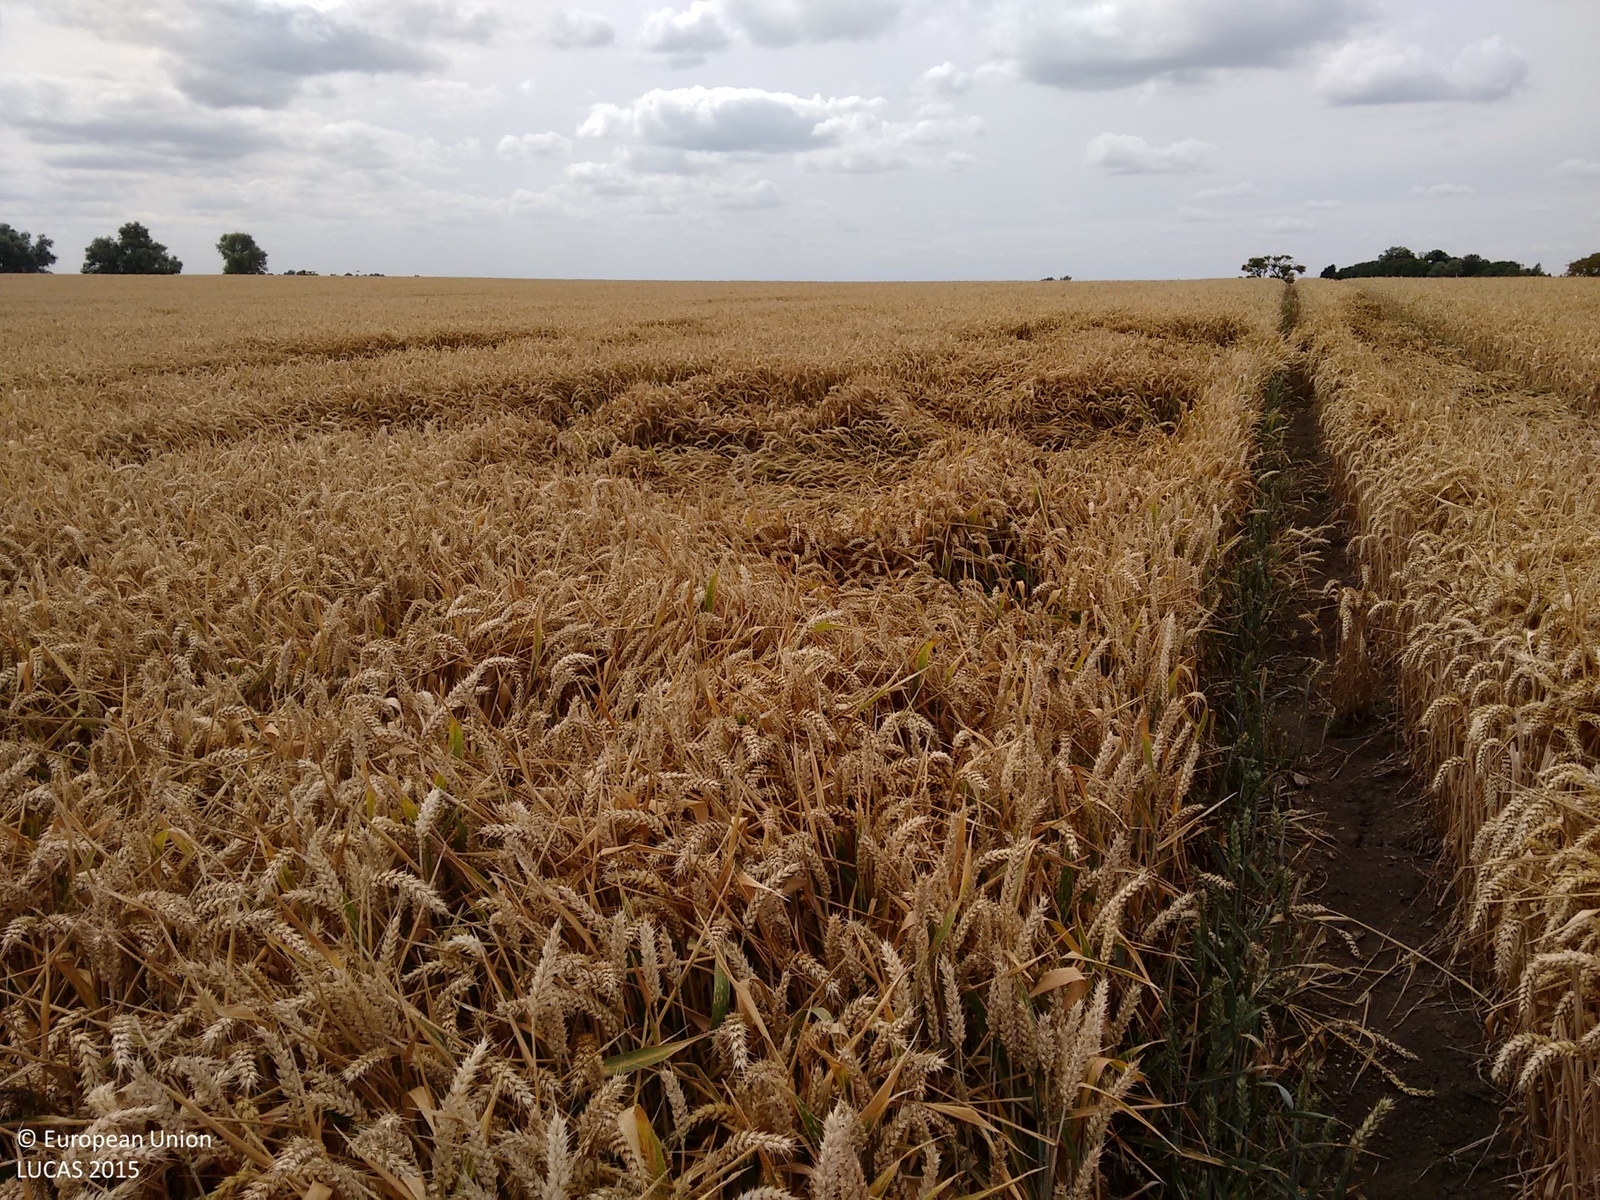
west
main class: Cropland
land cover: Common wheat
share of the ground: > 75 %
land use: Agriculture (excluding fallow land and kitchen gardens)
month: August
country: GB
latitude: 52.4861
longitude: 0.2954
